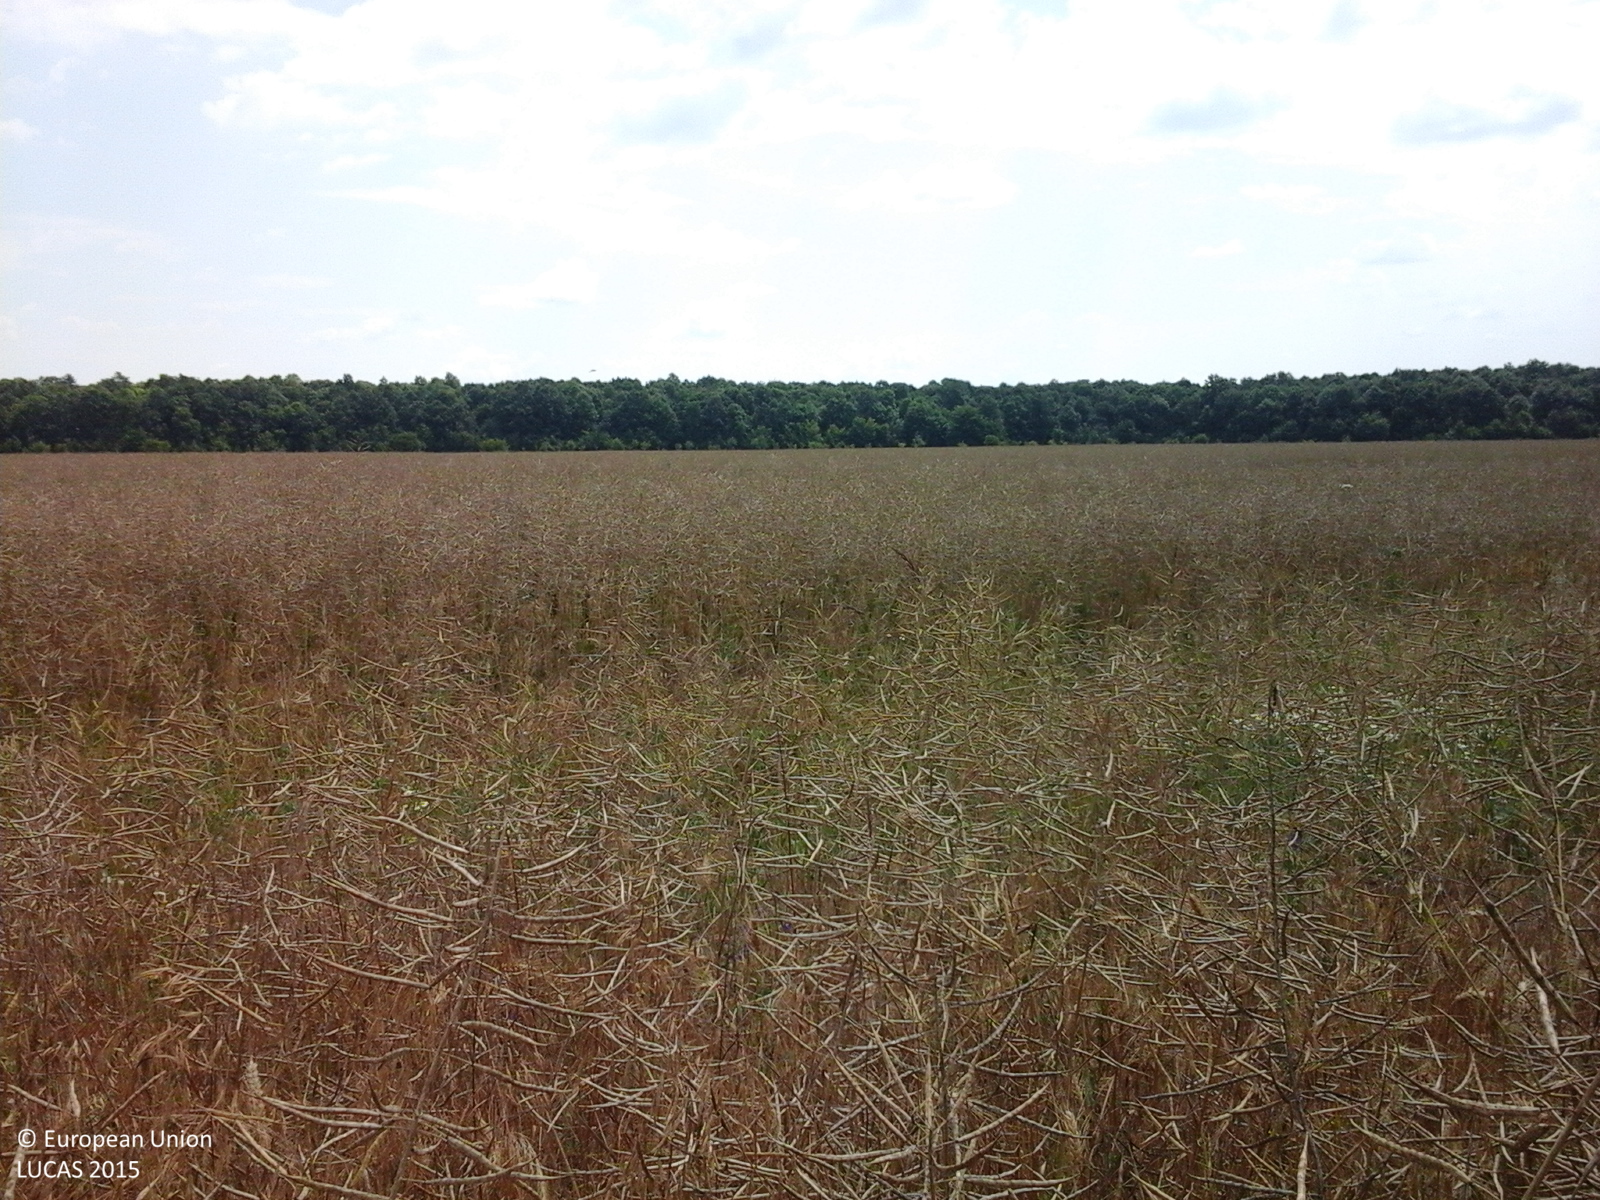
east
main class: Cropland
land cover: Rape and turnip rape
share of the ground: > 75 %
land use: Agriculture (excluding fallow land and kitchen gardens)
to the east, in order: Rape and turnip rape; Grassland with sparse tree/shrub cover
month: July
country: RO
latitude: 44.4831
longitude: 25.5967
